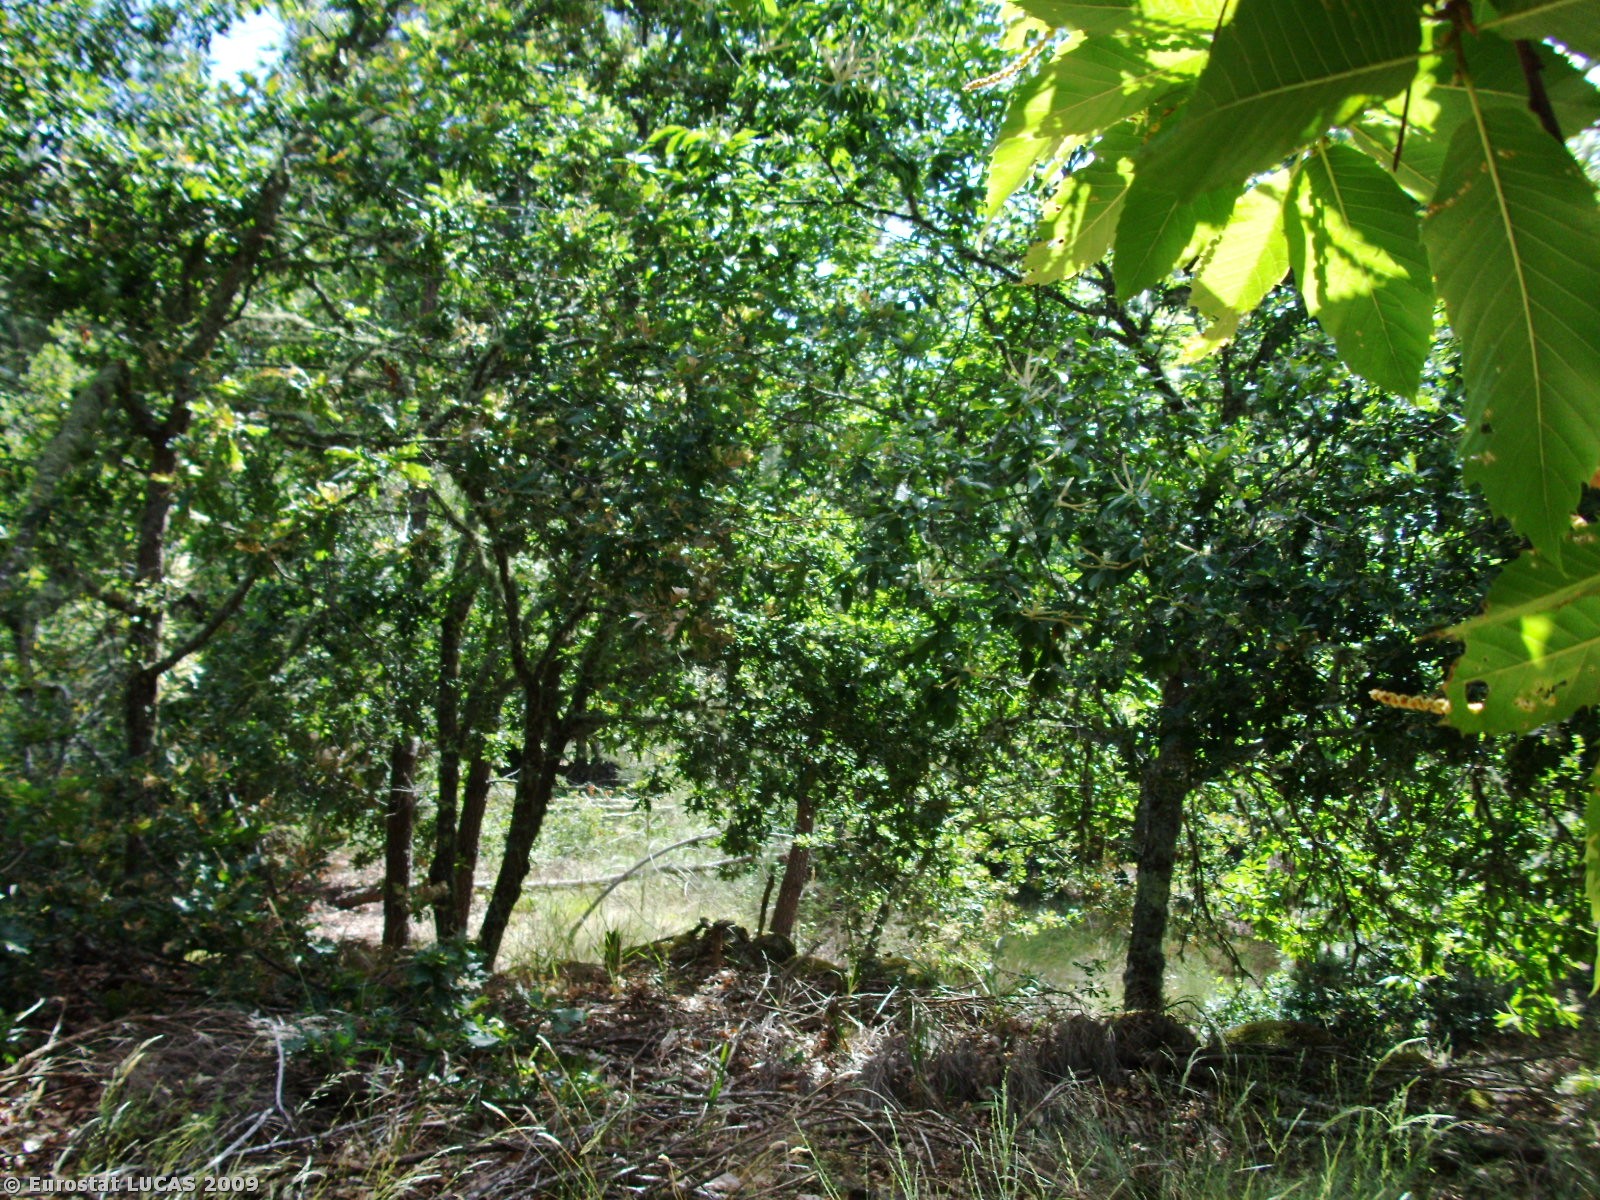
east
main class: Woodland
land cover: Broadleaved woodland
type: thermophilous deciduous forest
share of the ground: > 75 %
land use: Forestry
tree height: > 5 m
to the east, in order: Broadleaved woodland; Dry stone walls; Broadleaved woodland; Dry stone walls; Coniferous woodland; Dry stone walls; Tracks; Dry stone walls; Shrubland without tree cover; Mixed woodland; Dry stone walls; Shrubland with sparse tree cover; Broadleaved woodland
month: July
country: PT
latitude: 40.8212
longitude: -7.7048
